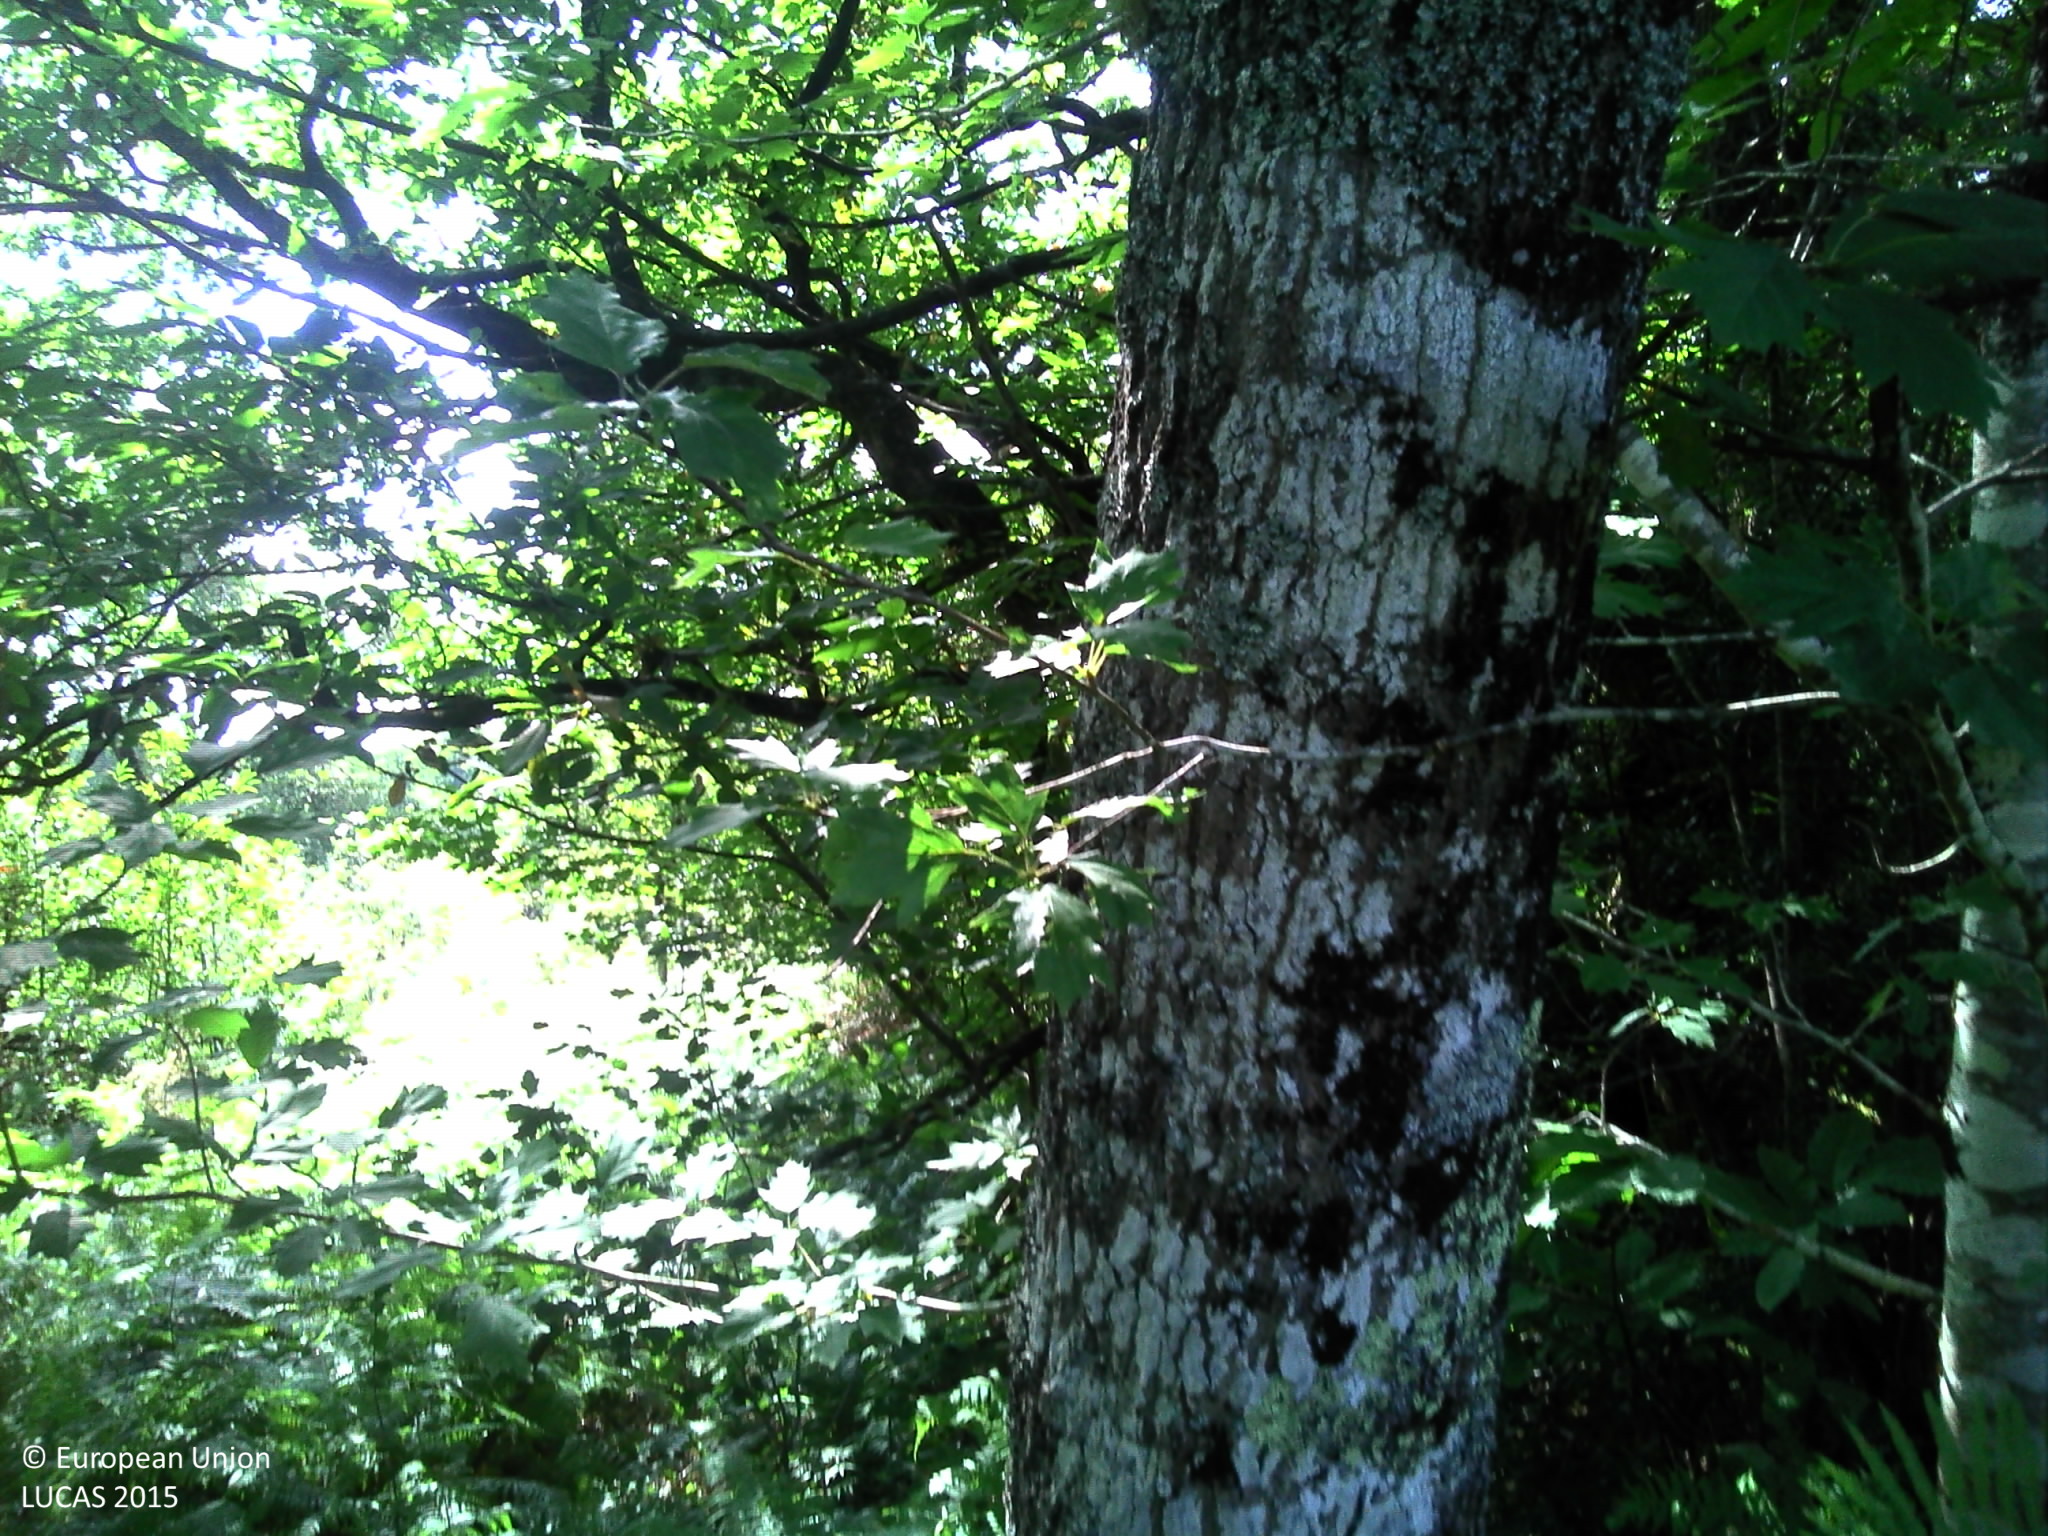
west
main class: Woodland
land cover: Broadleaved woodland
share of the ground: > 75 %
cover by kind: broadleaved forest trees 75 %, shrubs 15 %, herbaceous plants 10 %
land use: Forestry
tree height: > 5 m
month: July
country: FR
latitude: 43.8071
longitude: -0.5906
